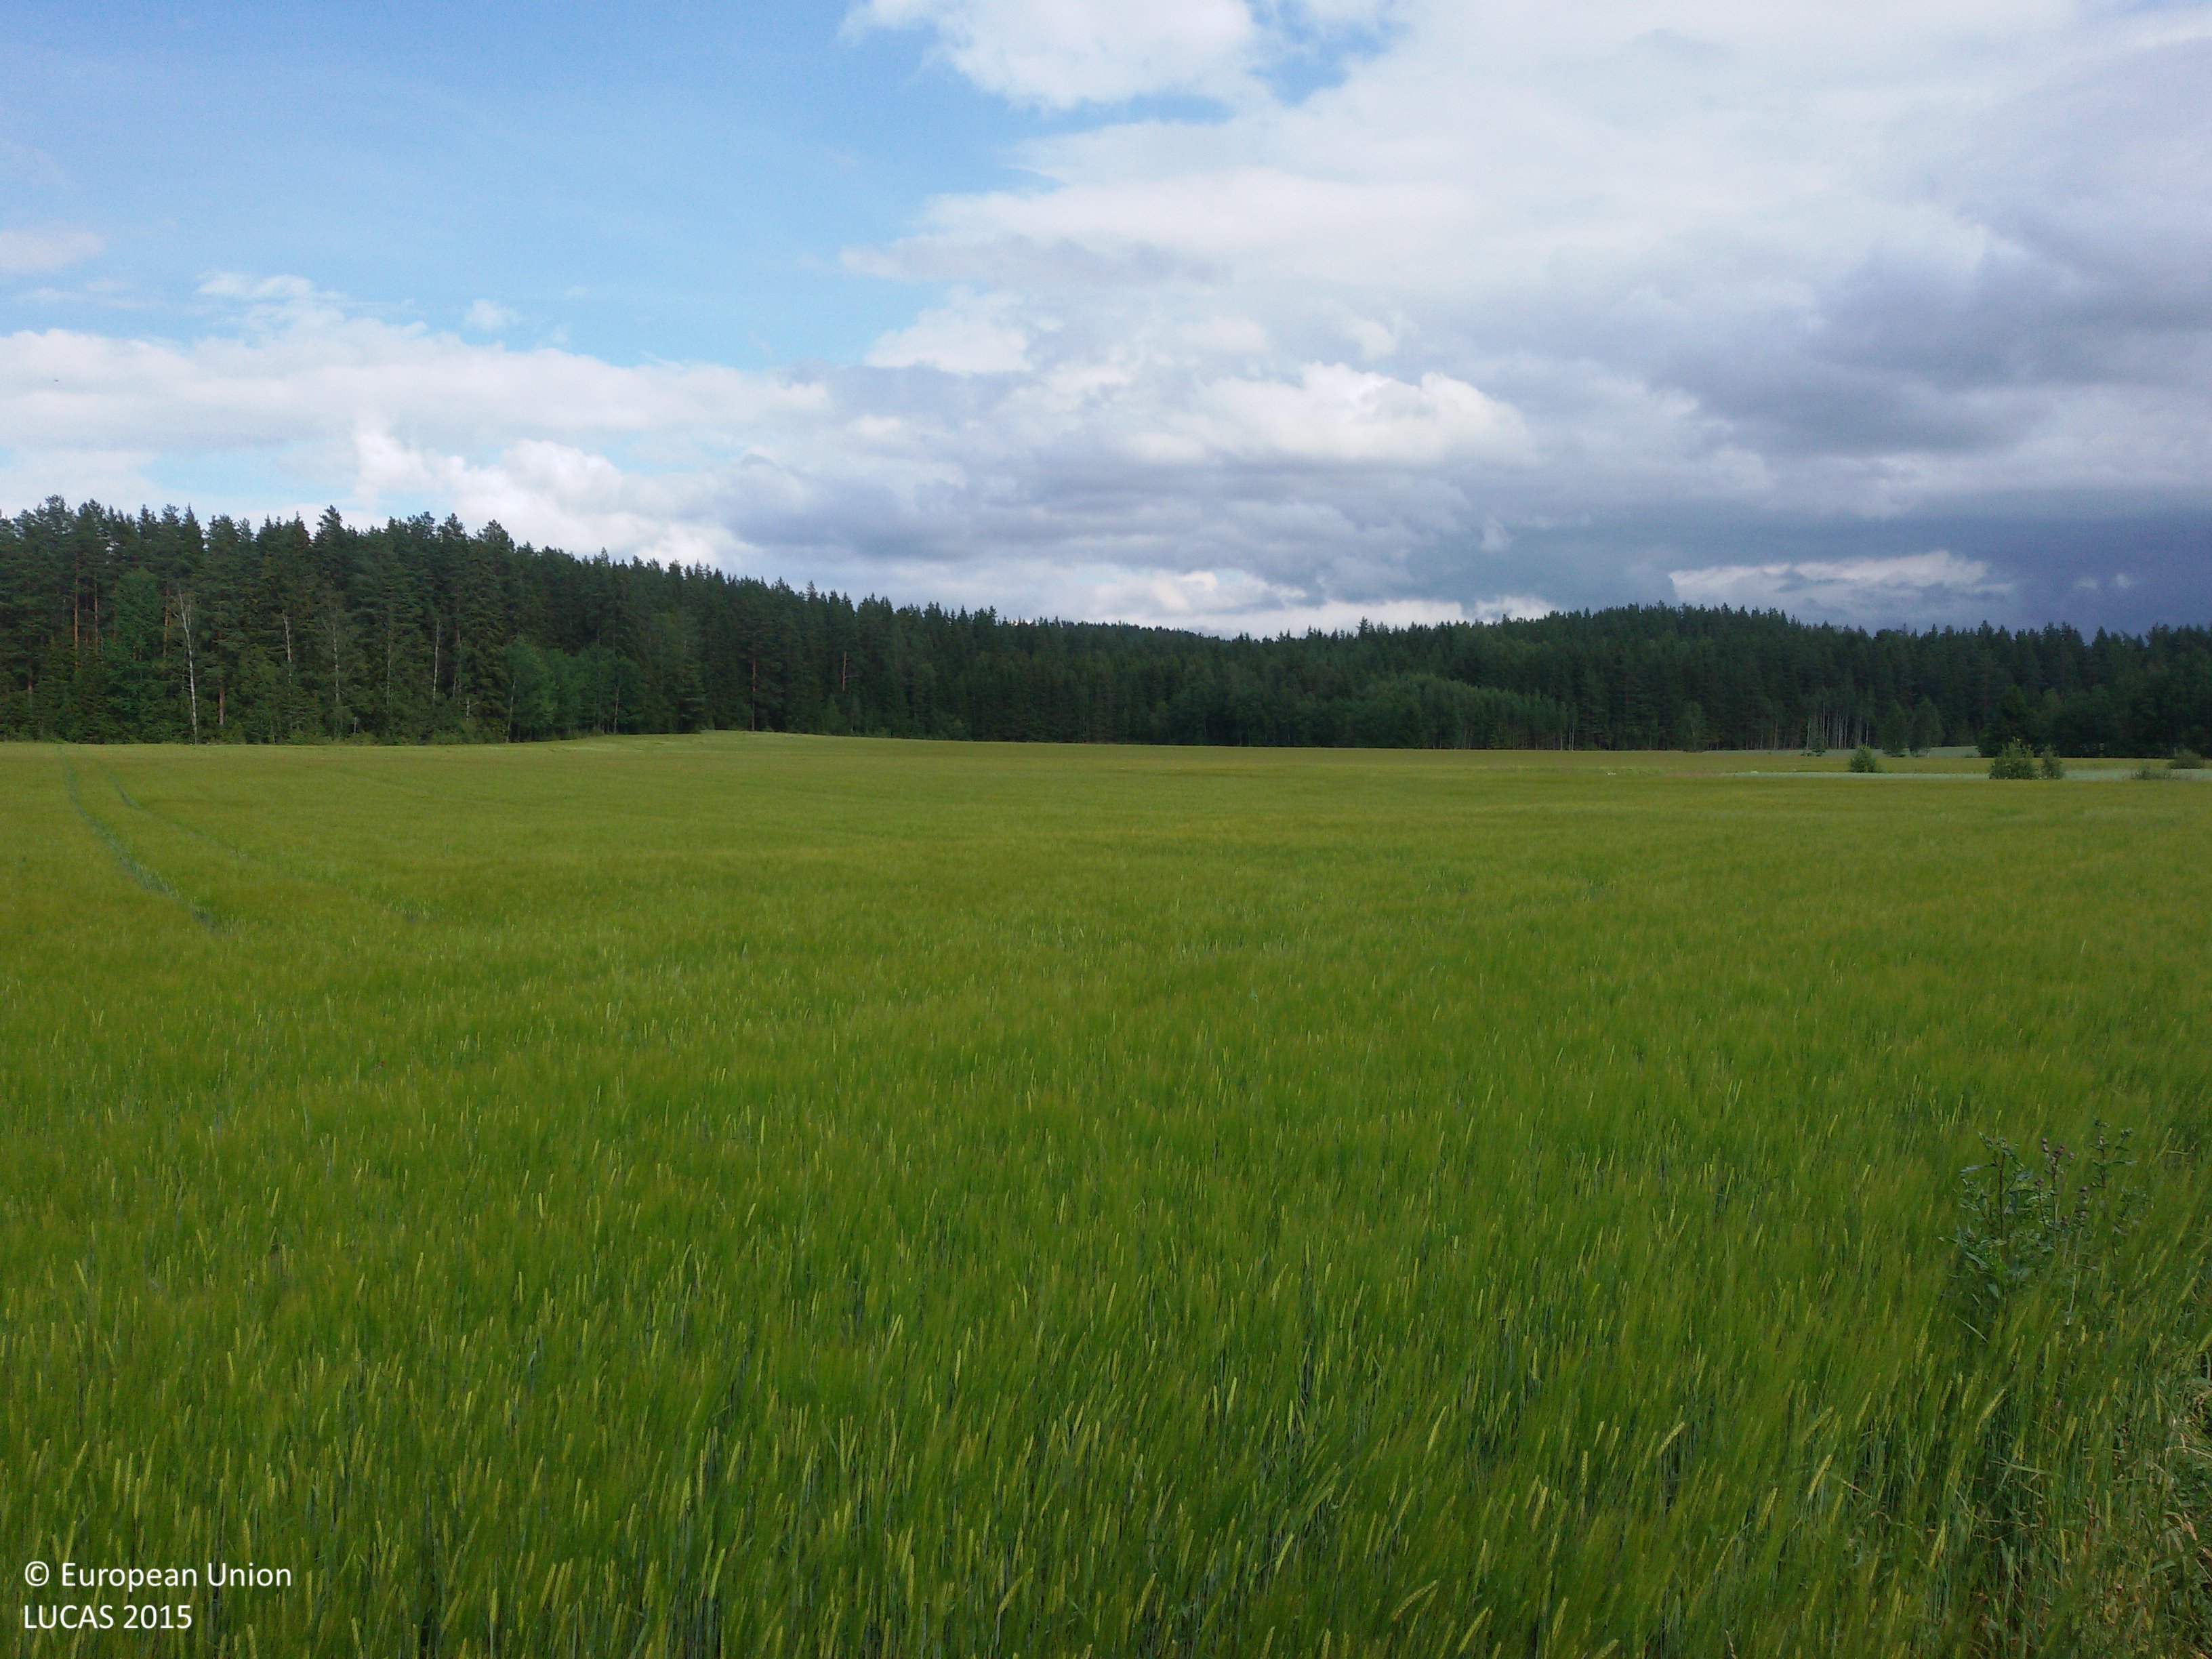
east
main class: Cropland
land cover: Barley
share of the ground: > 75 %
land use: Agriculture (excluding fallow land and kitchen gardens)
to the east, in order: Barley; Spruce dominated coniferous woodland; Pine dominated coniferous woodland
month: July
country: SE
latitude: 60.4292
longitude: 16.0739
